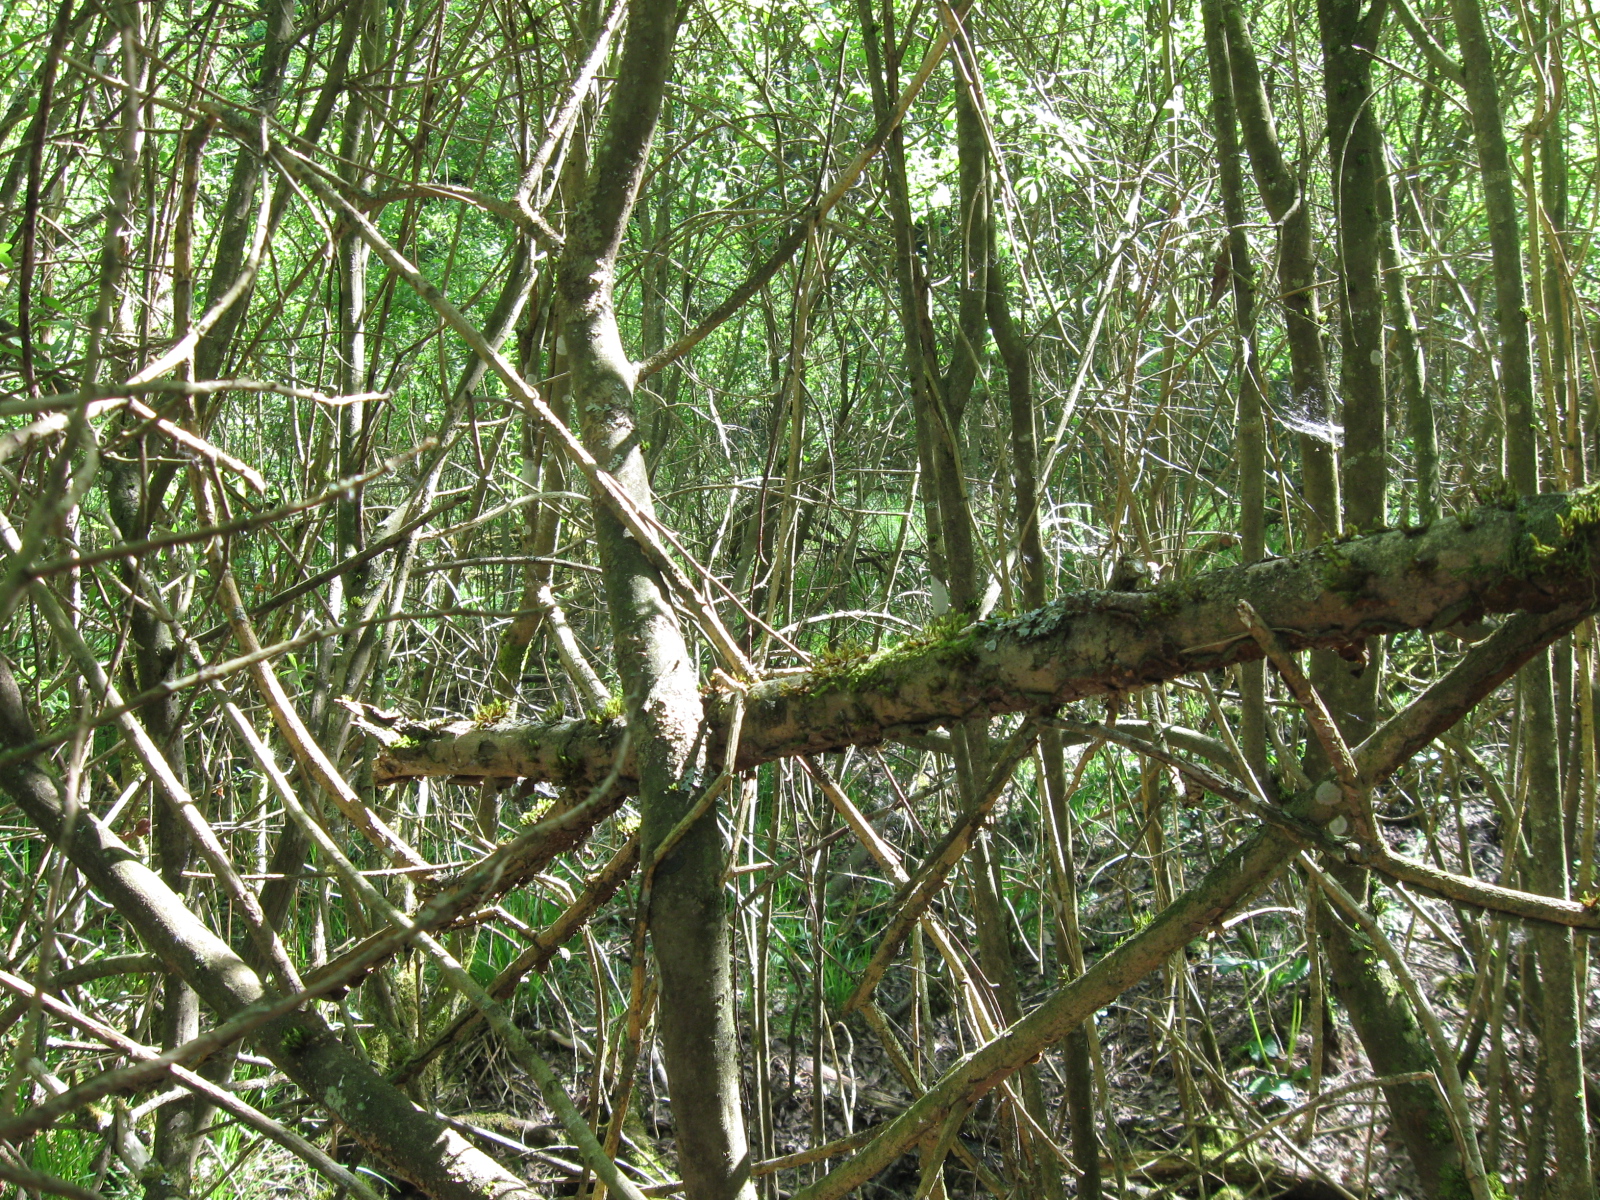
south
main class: Woodland
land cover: Spruce dominated mixed woodland
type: hemiboreal forest and nemoral coniferous forest and mixed broadleaved-coniferous forest
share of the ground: > 75 %
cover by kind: broadleaved forest trees 65 %, coniferous forest trees 30 %, herbaceous plants 5 %
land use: Forestry
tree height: > 5 m
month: June
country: LT
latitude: 54.1058
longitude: 23.6207
